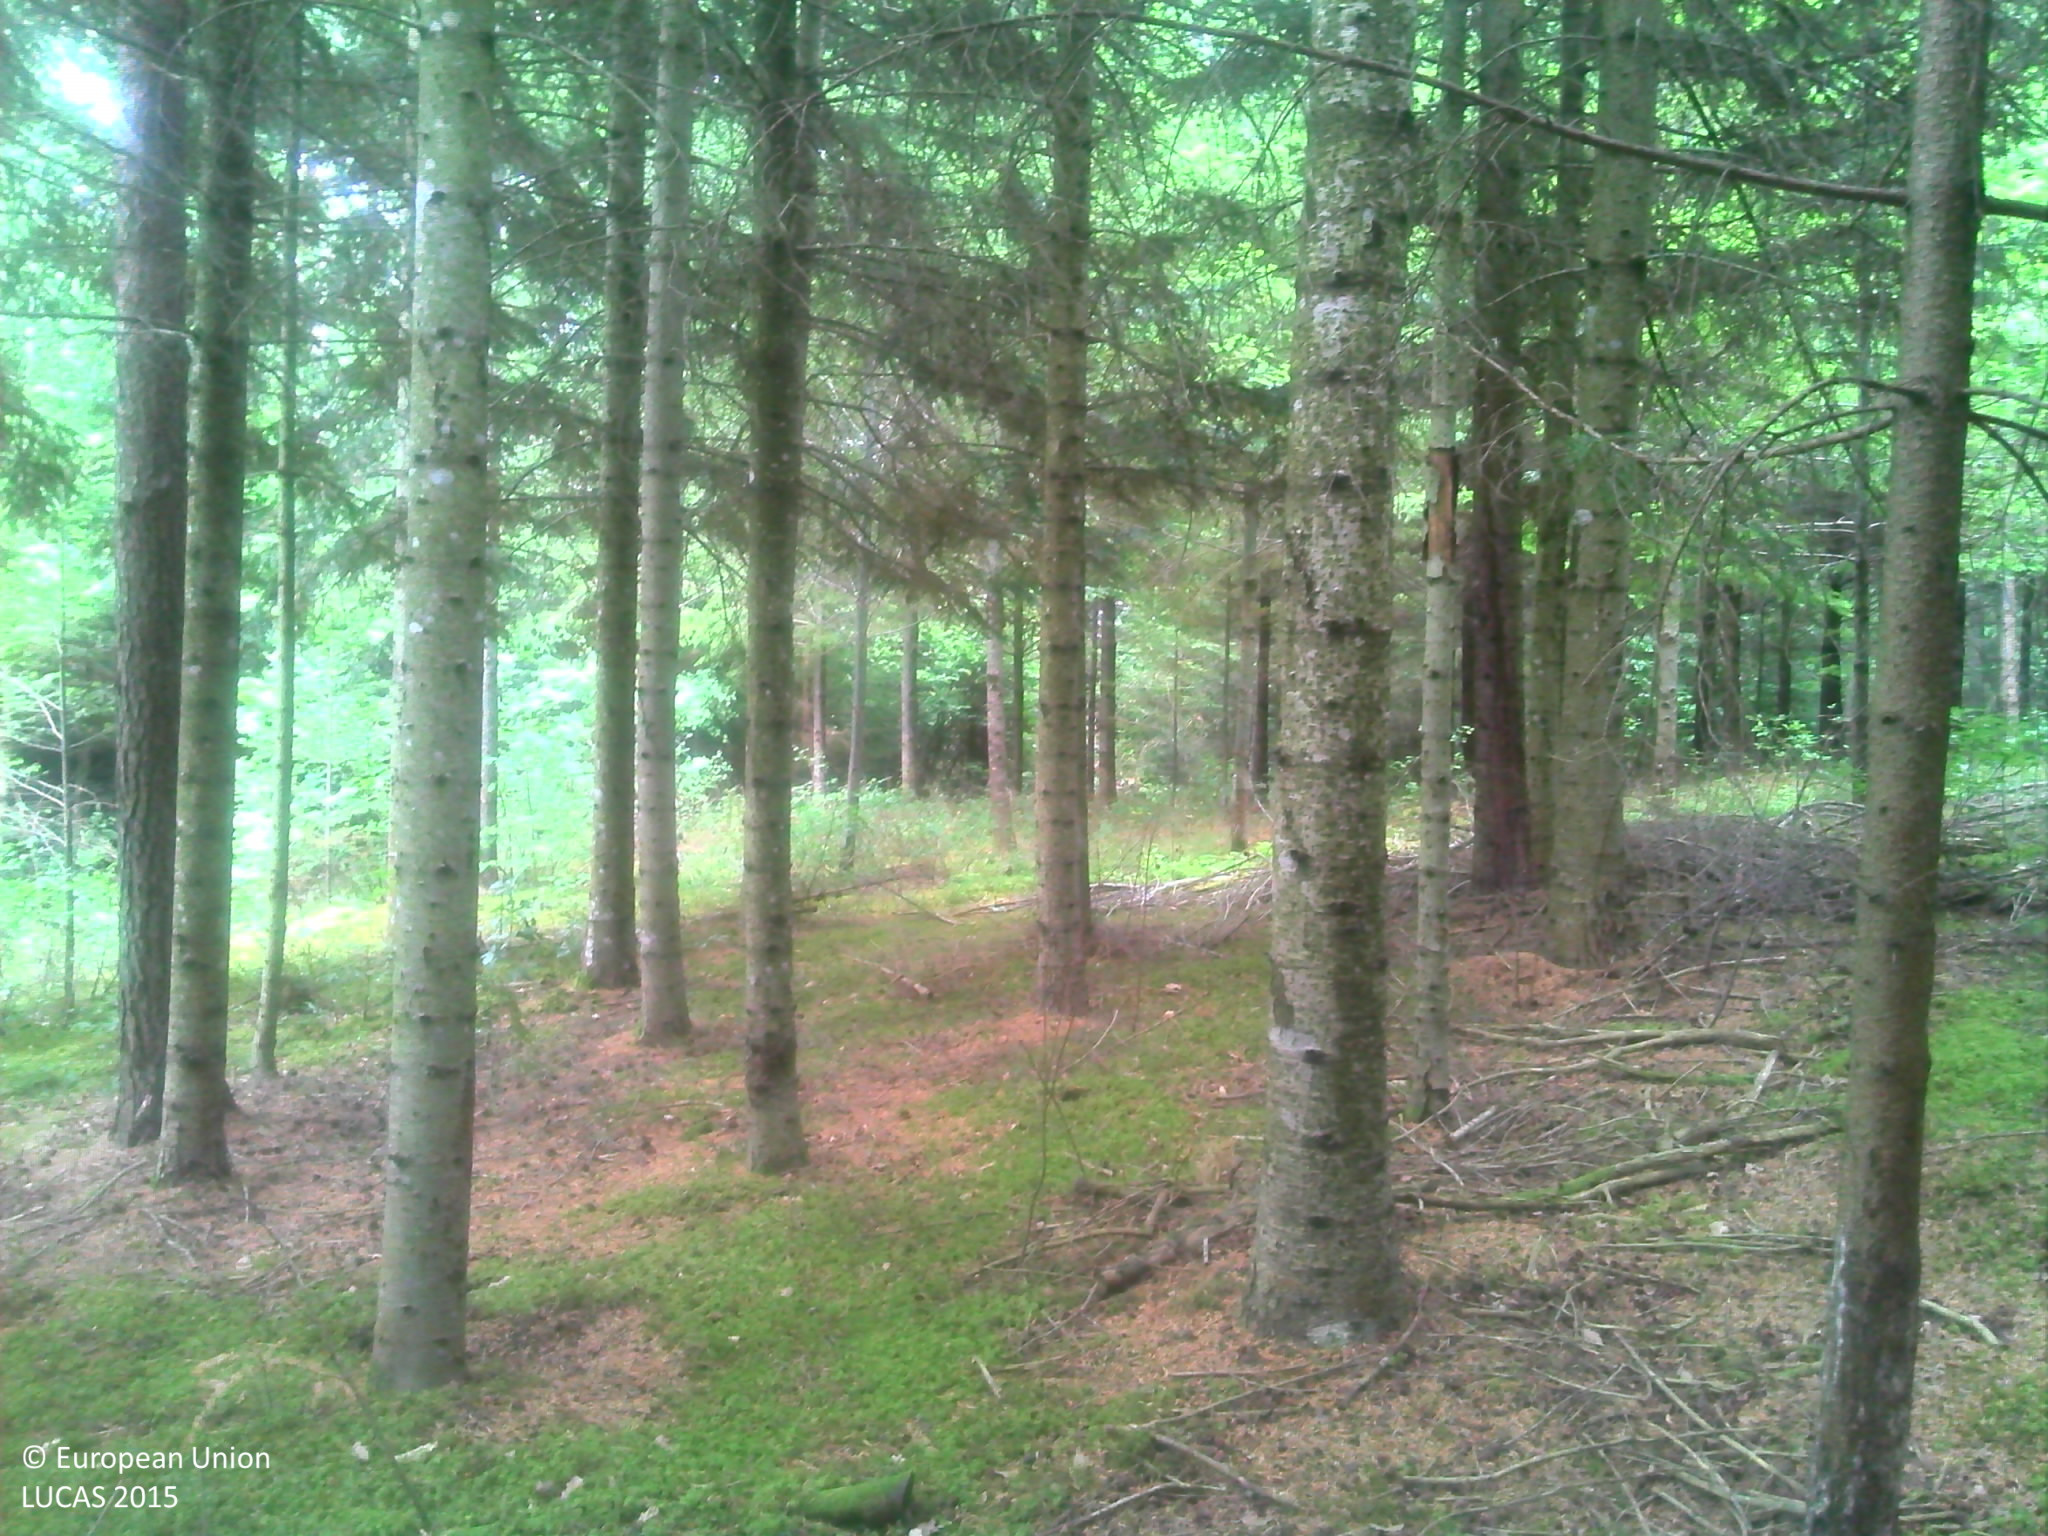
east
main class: Woodland
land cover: Spruce dominated coniferous woodland
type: exotic forest
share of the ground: > 75 %
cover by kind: coniferous forest trees 80 %, lichens and mosses 10 %, herbaceous plants 5 %, unconsolidated bare surface 5 %
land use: Forestry
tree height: > 5 m
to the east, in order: Spruce dominated coniferous woodland; Spruce dominated mixed woodland; Tracks; Spruce dominated mixed woodland; Tracks; Spruce dominated mixed woodland
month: July
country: FR
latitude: 45.1630
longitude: 3.8590
